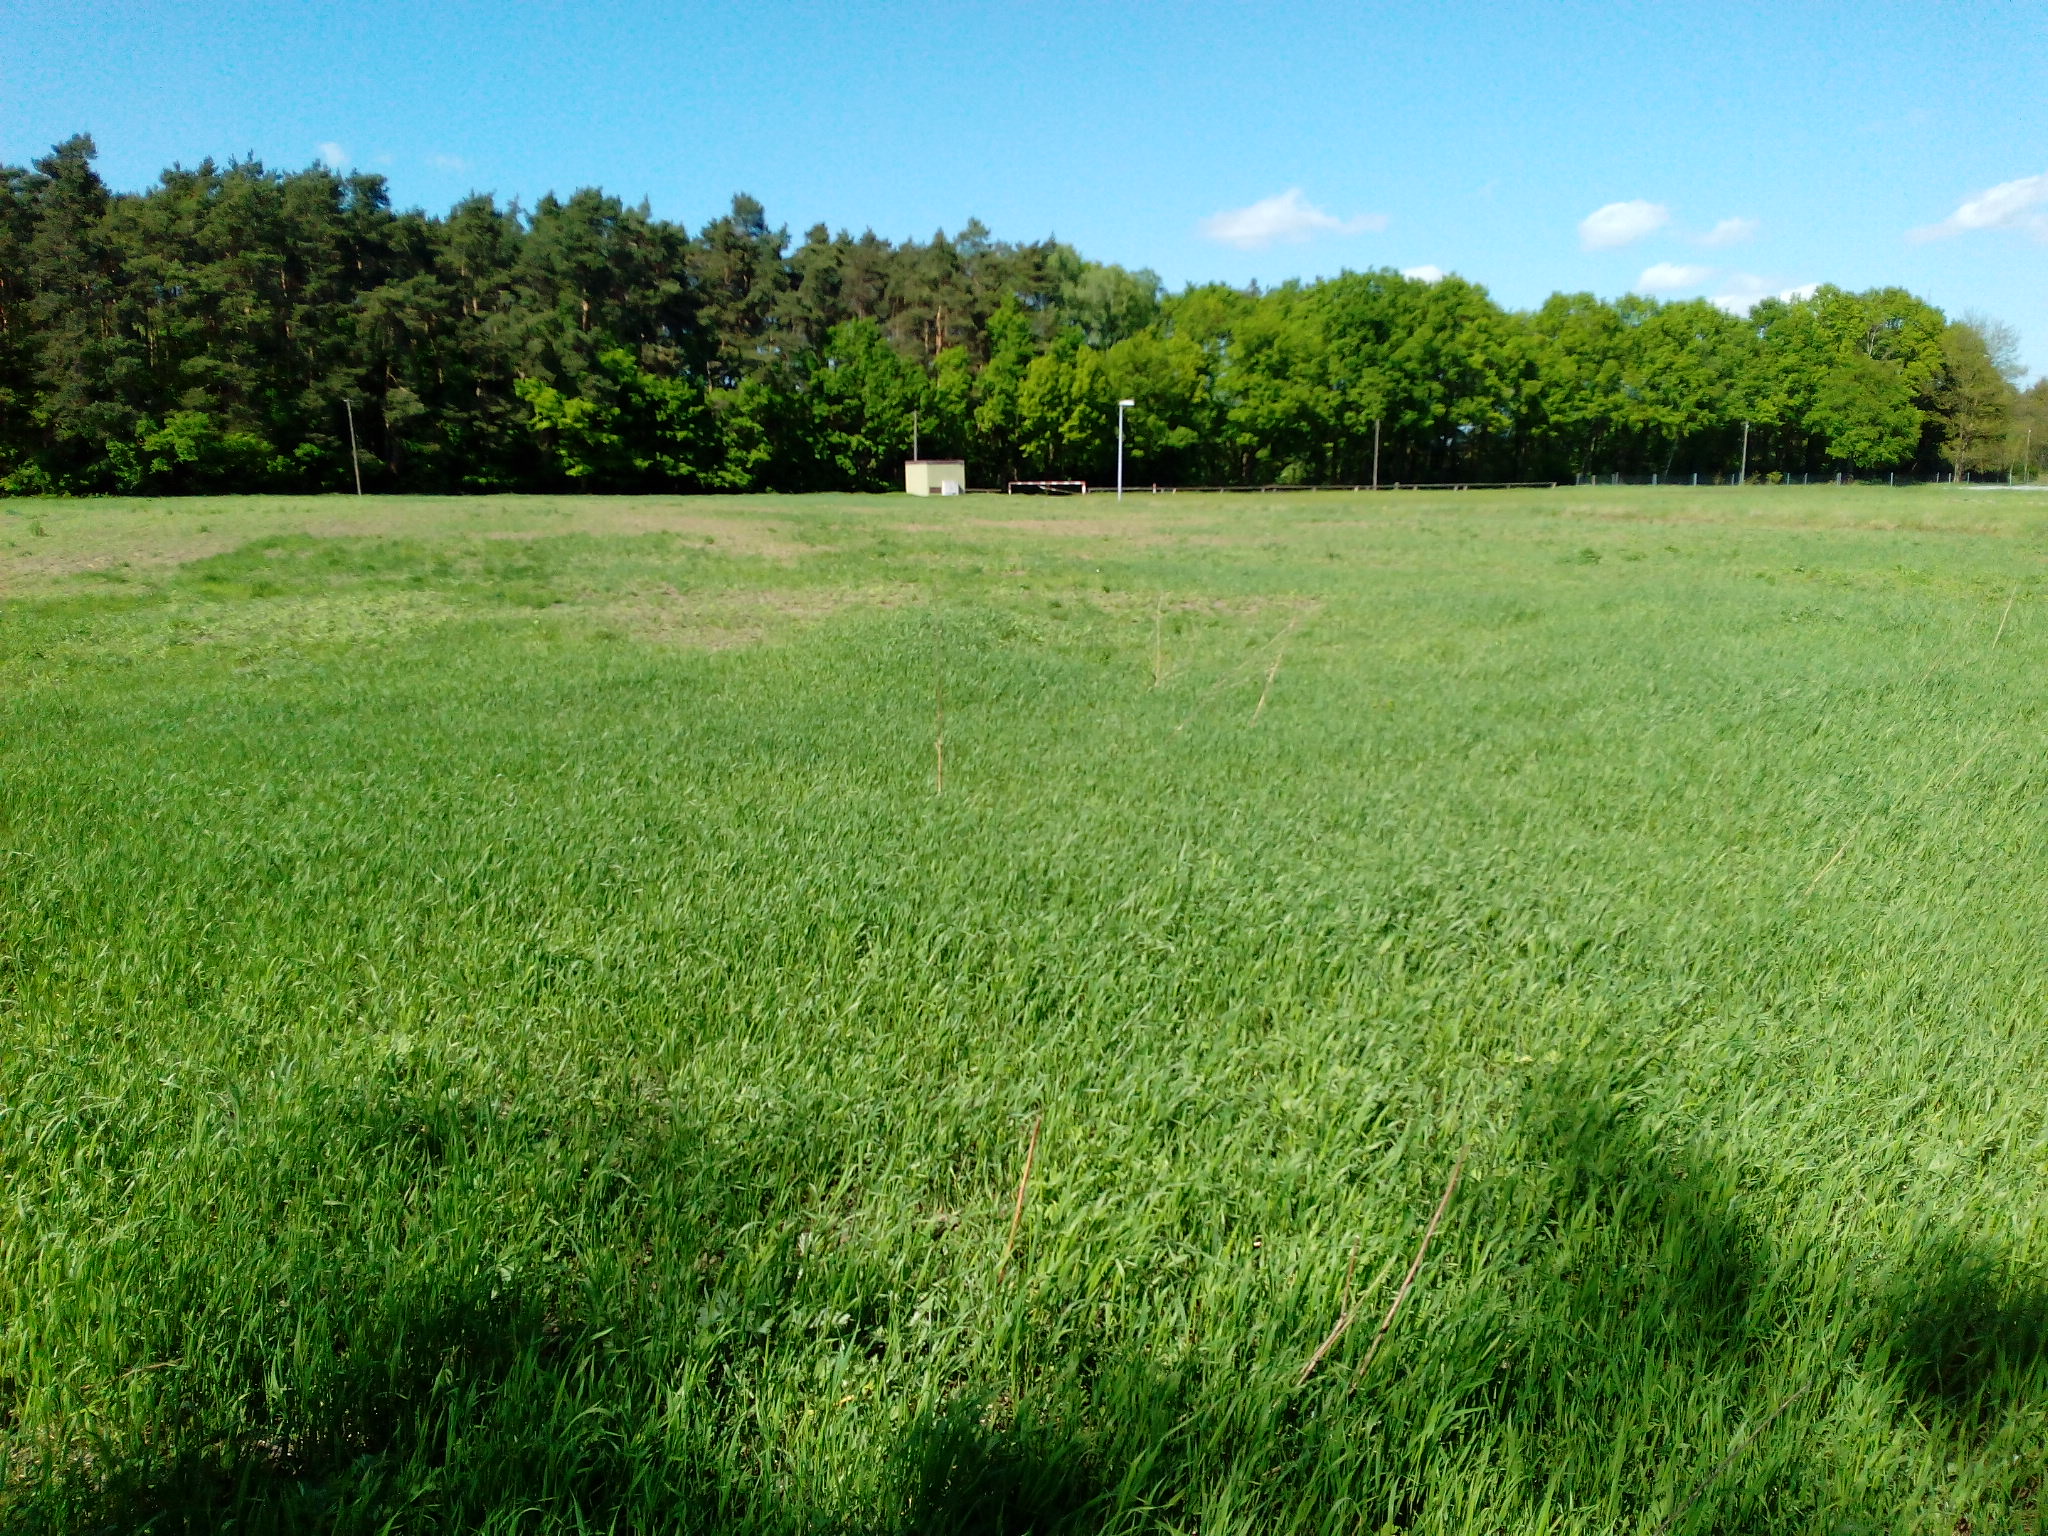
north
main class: Grassland
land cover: Grassland without tree/shrub cover
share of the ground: > 75 %
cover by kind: herbaceous plants 100 %
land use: Agriculture (excluding fallow land and kitchen gardens)
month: May
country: DE
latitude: 52.4673
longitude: 9.8970
